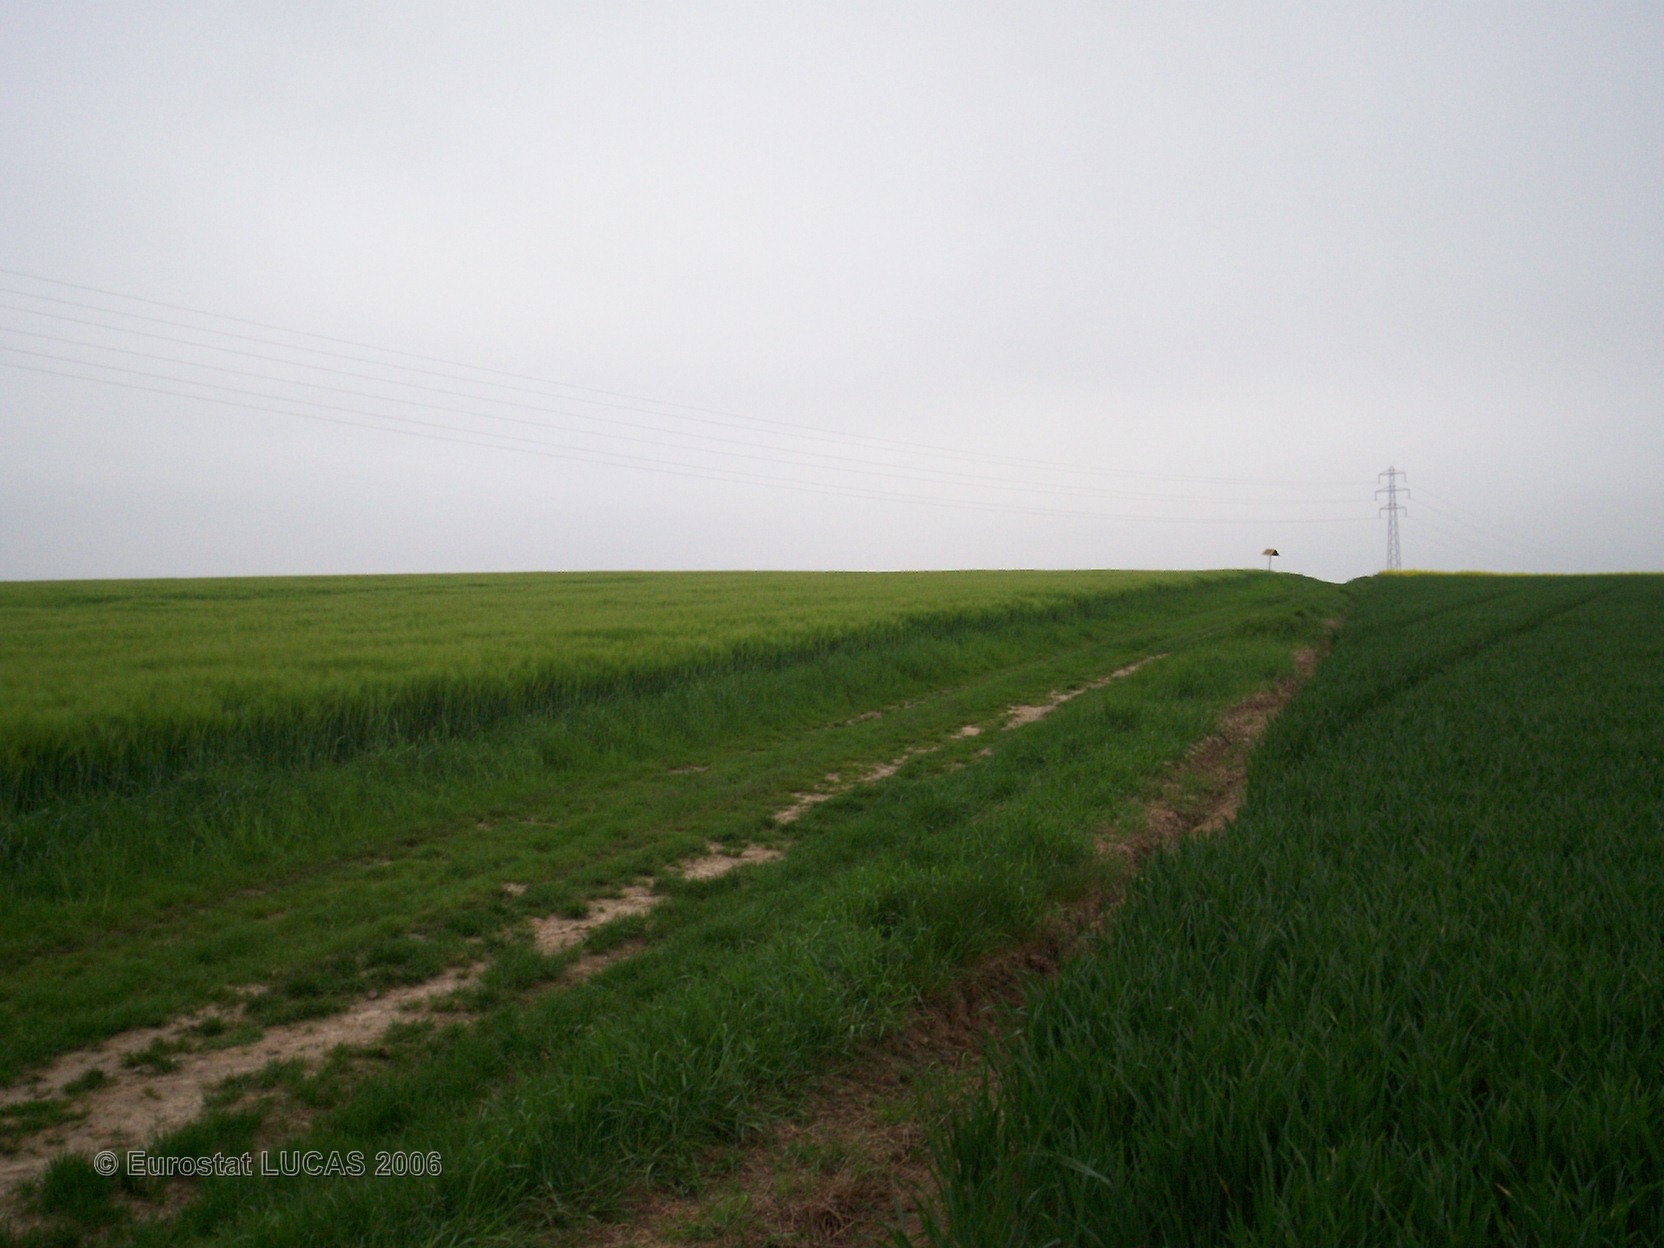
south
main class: Cropland
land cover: Common wheat
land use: Agriculture (excluding fallow land and kitchen gardens)
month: May
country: FR
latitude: 49.5018
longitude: 4.3204
